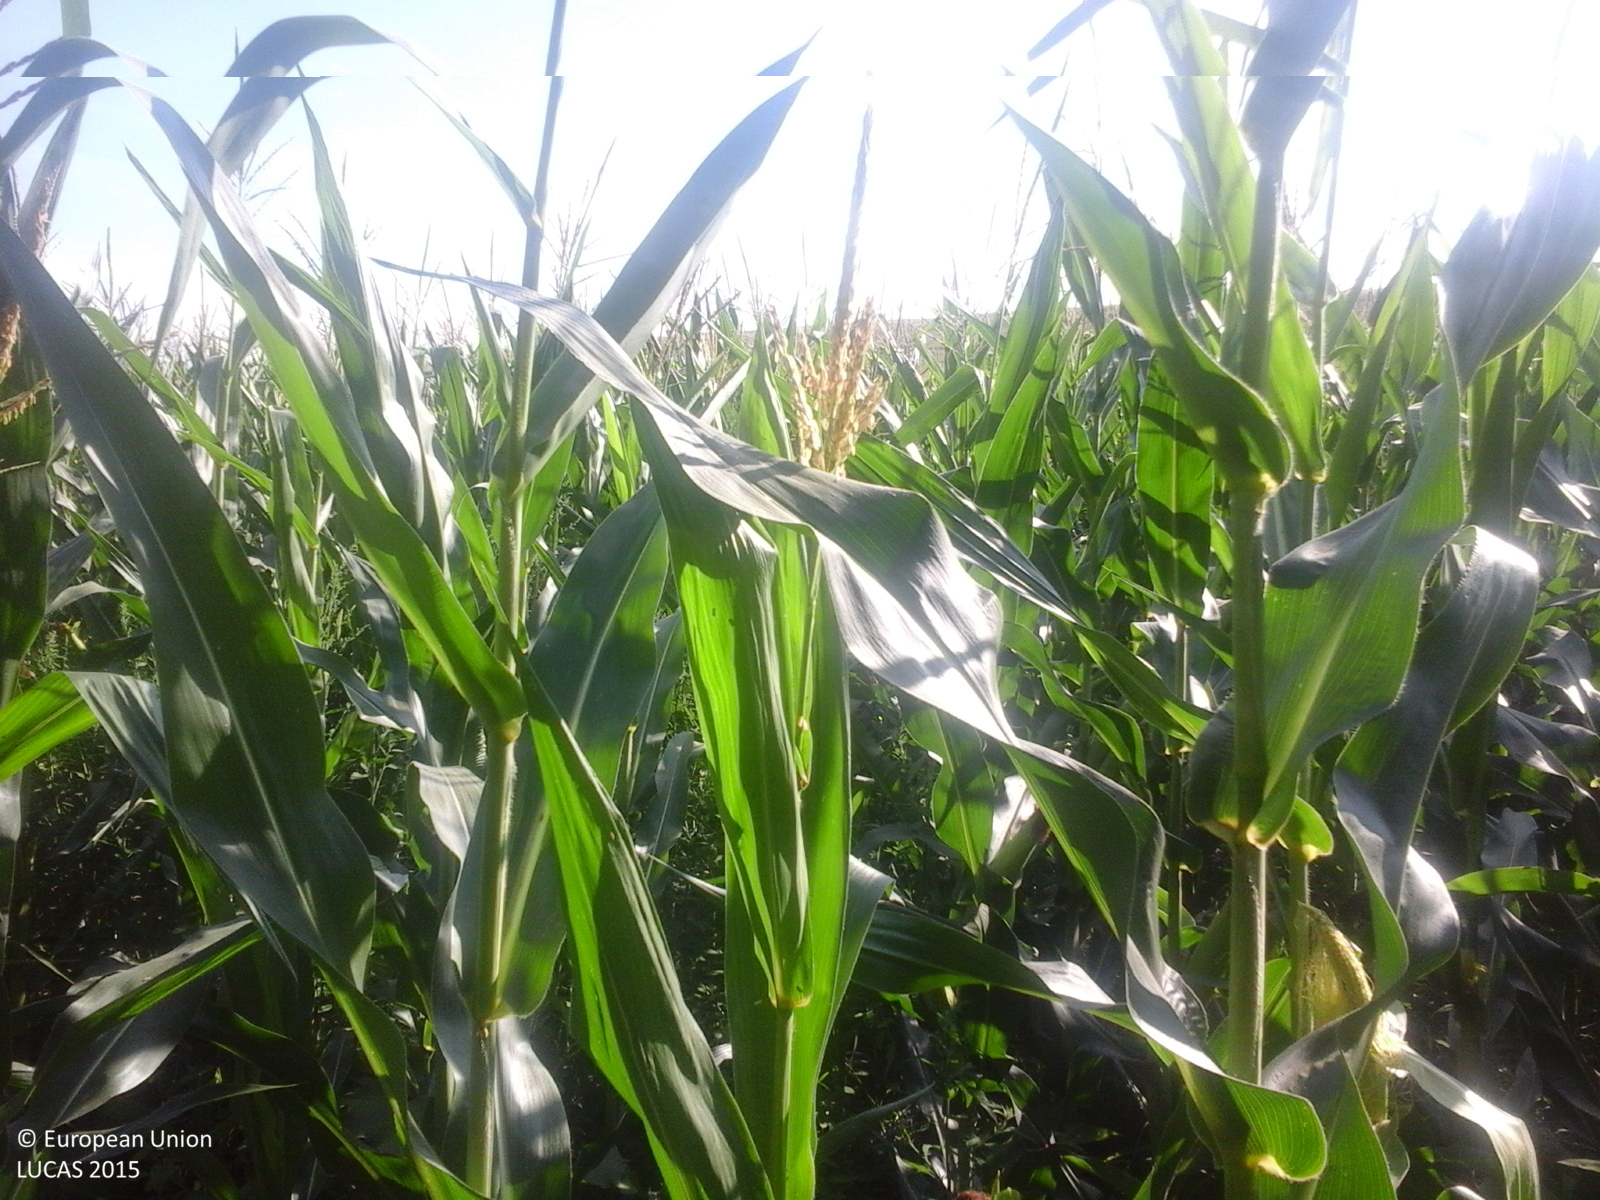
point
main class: Cropland
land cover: Maize
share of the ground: > 75 %
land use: Agriculture (excluding fallow land and kitchen gardens)
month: July
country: RO
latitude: 46.4356
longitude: 27.9683
